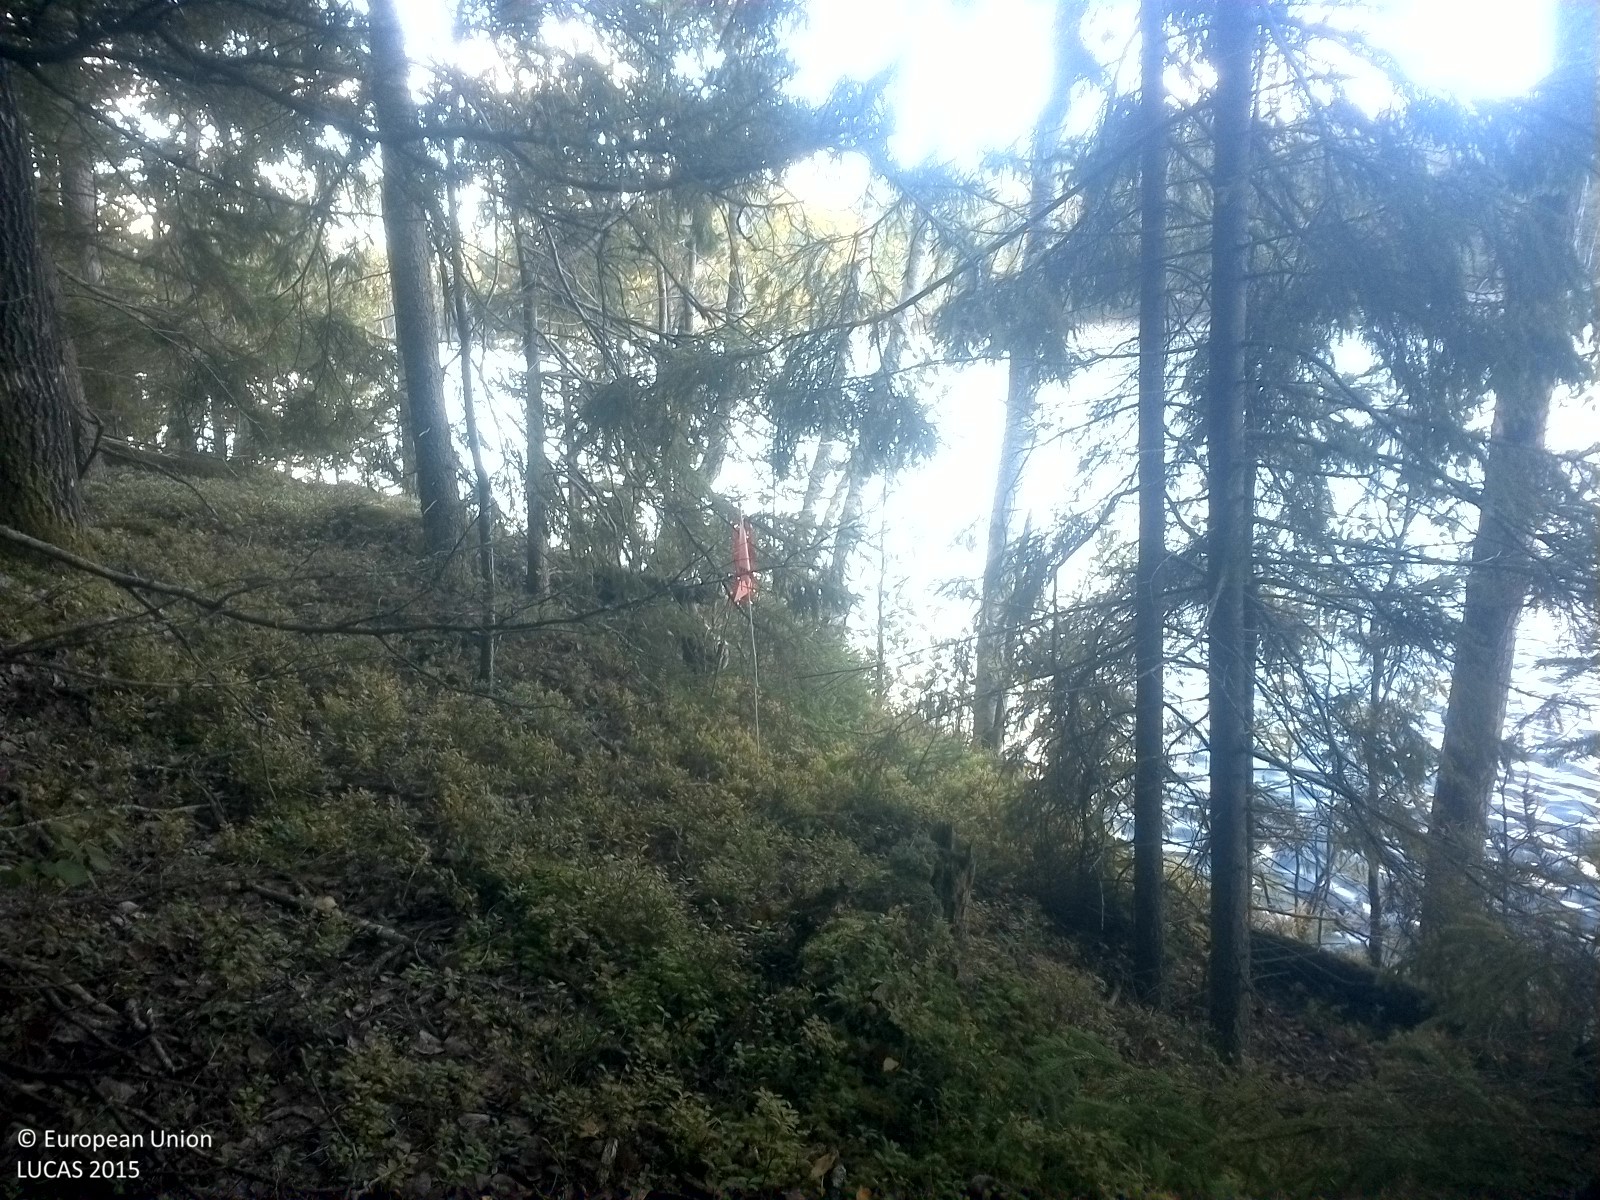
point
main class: Woodland
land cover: Spruce dominated mixed woodland
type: boreal forest
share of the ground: 50 - 75 %
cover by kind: coniferous forest trees 35 %, herbaceous plants 35 %, broadleaved forest trees 20 %, lichens and mosses 10 %
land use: Forestry
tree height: > 5 m
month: September
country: SE
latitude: 58.7607
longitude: 16.2354
